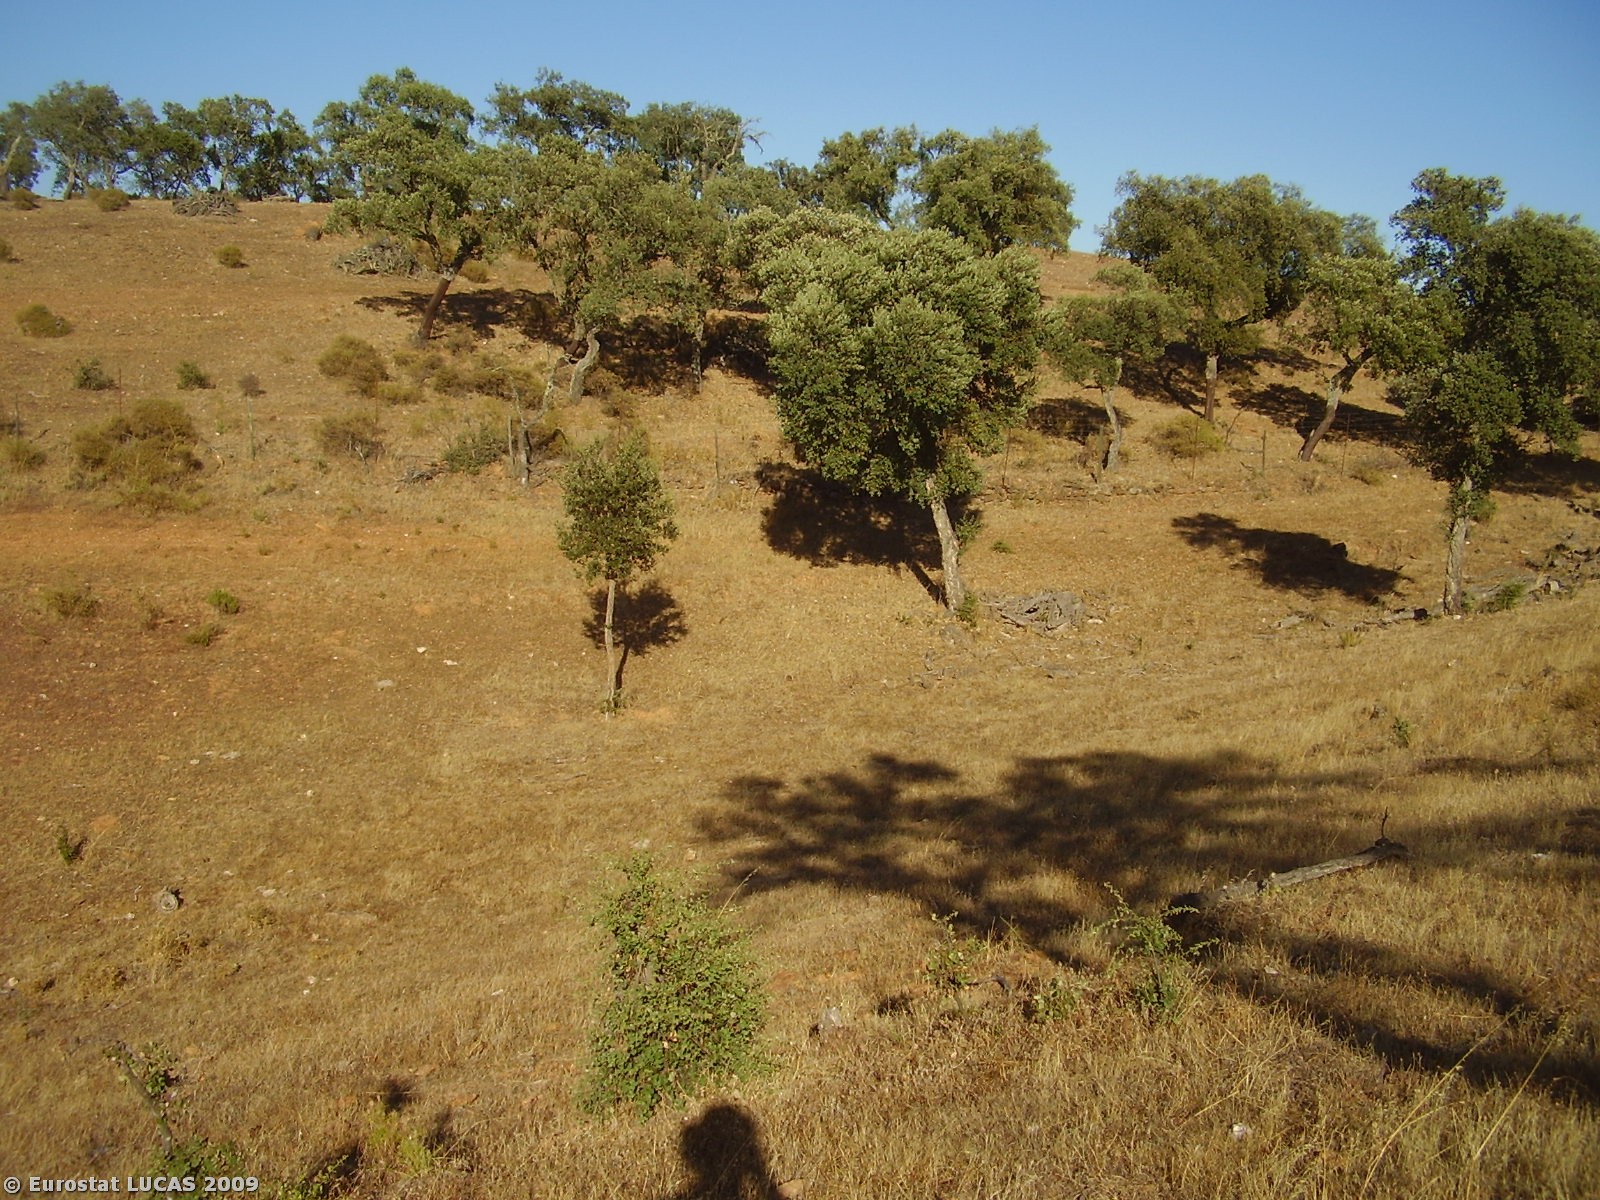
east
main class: Woodland
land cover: Broadleaved woodland
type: broadleaved evergreen forest
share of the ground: 10 - 25 %
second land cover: Grassland with sparse tree/shrub cover
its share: > 75 %
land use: Forestry
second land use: Fallow land
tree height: > 5 m
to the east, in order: Broadleaved woodland; Grassland with sparse tree/shrub cover; Broadleaved woodland; Fences; Broadleaved woodland; Spontaneously vegetated surfaces; Ditches and canals; Rock outcrops; Spontaneously vegetated surfaces
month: July
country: PT
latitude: 37.8088
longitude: -7.5192
